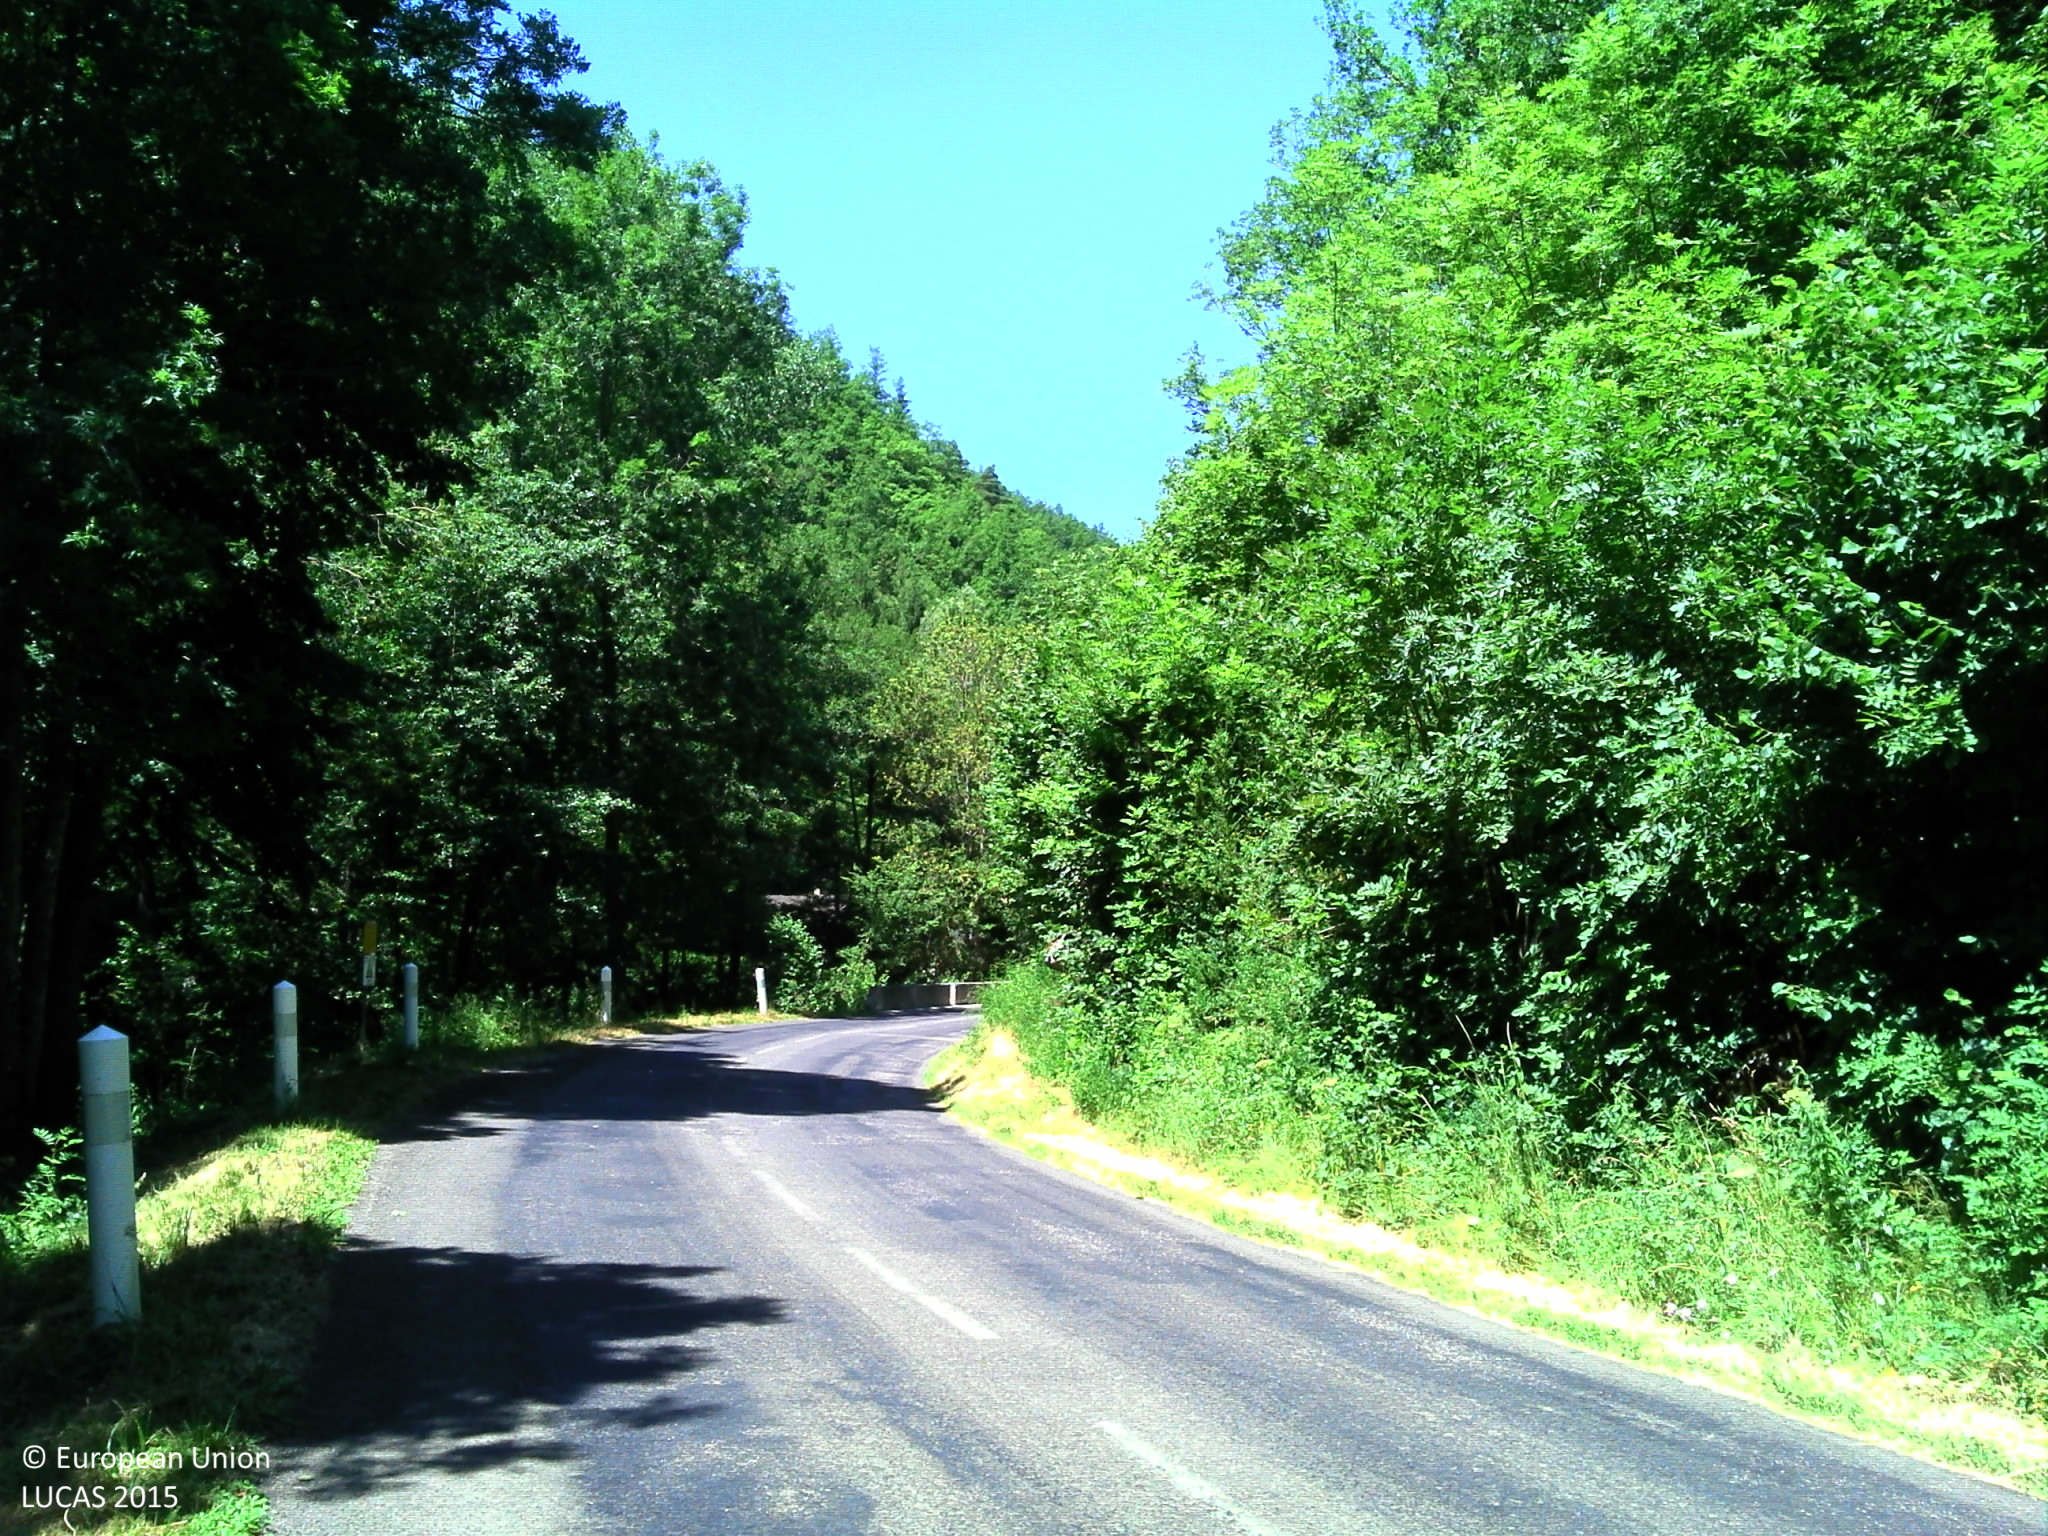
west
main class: Woodland
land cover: Broadleaved woodland
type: mesophytic deciduous forest
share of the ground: > 75 %
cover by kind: broadleaved forest trees 90 %, herbaceous plants 10 %
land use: Semi-natural and natural areas not in use
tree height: > 5 m
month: July
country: FR
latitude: 42.7266
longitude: 2.1083
